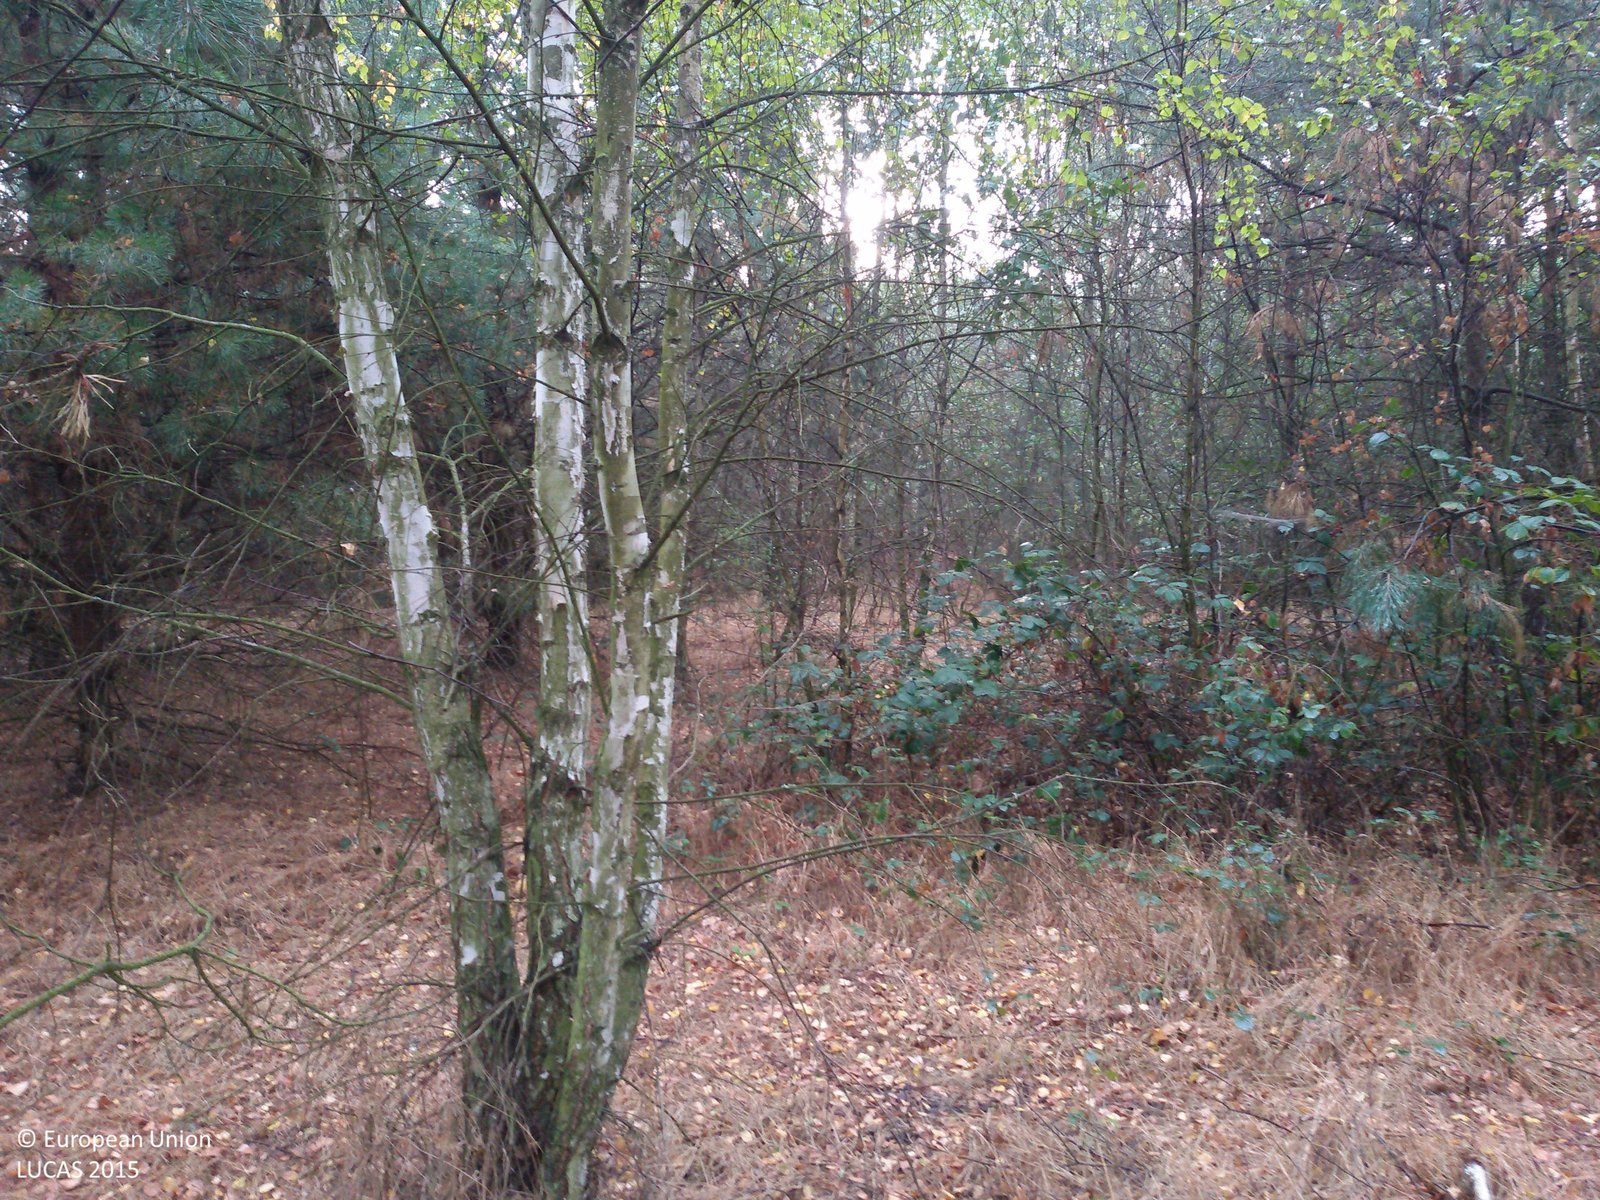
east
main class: Woodland
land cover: Broadleaved woodland
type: mesophytic deciduous forest
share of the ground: > 75 %
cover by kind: broadleaved forest trees 70 %, coniferous forest trees 15 %, herbaceous plants 15 %
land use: Forestry
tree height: > 5 m
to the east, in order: Broadleaved woodland; Pine dominated mixed woodland
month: September
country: PL
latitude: 51.3231
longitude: 18.8473
